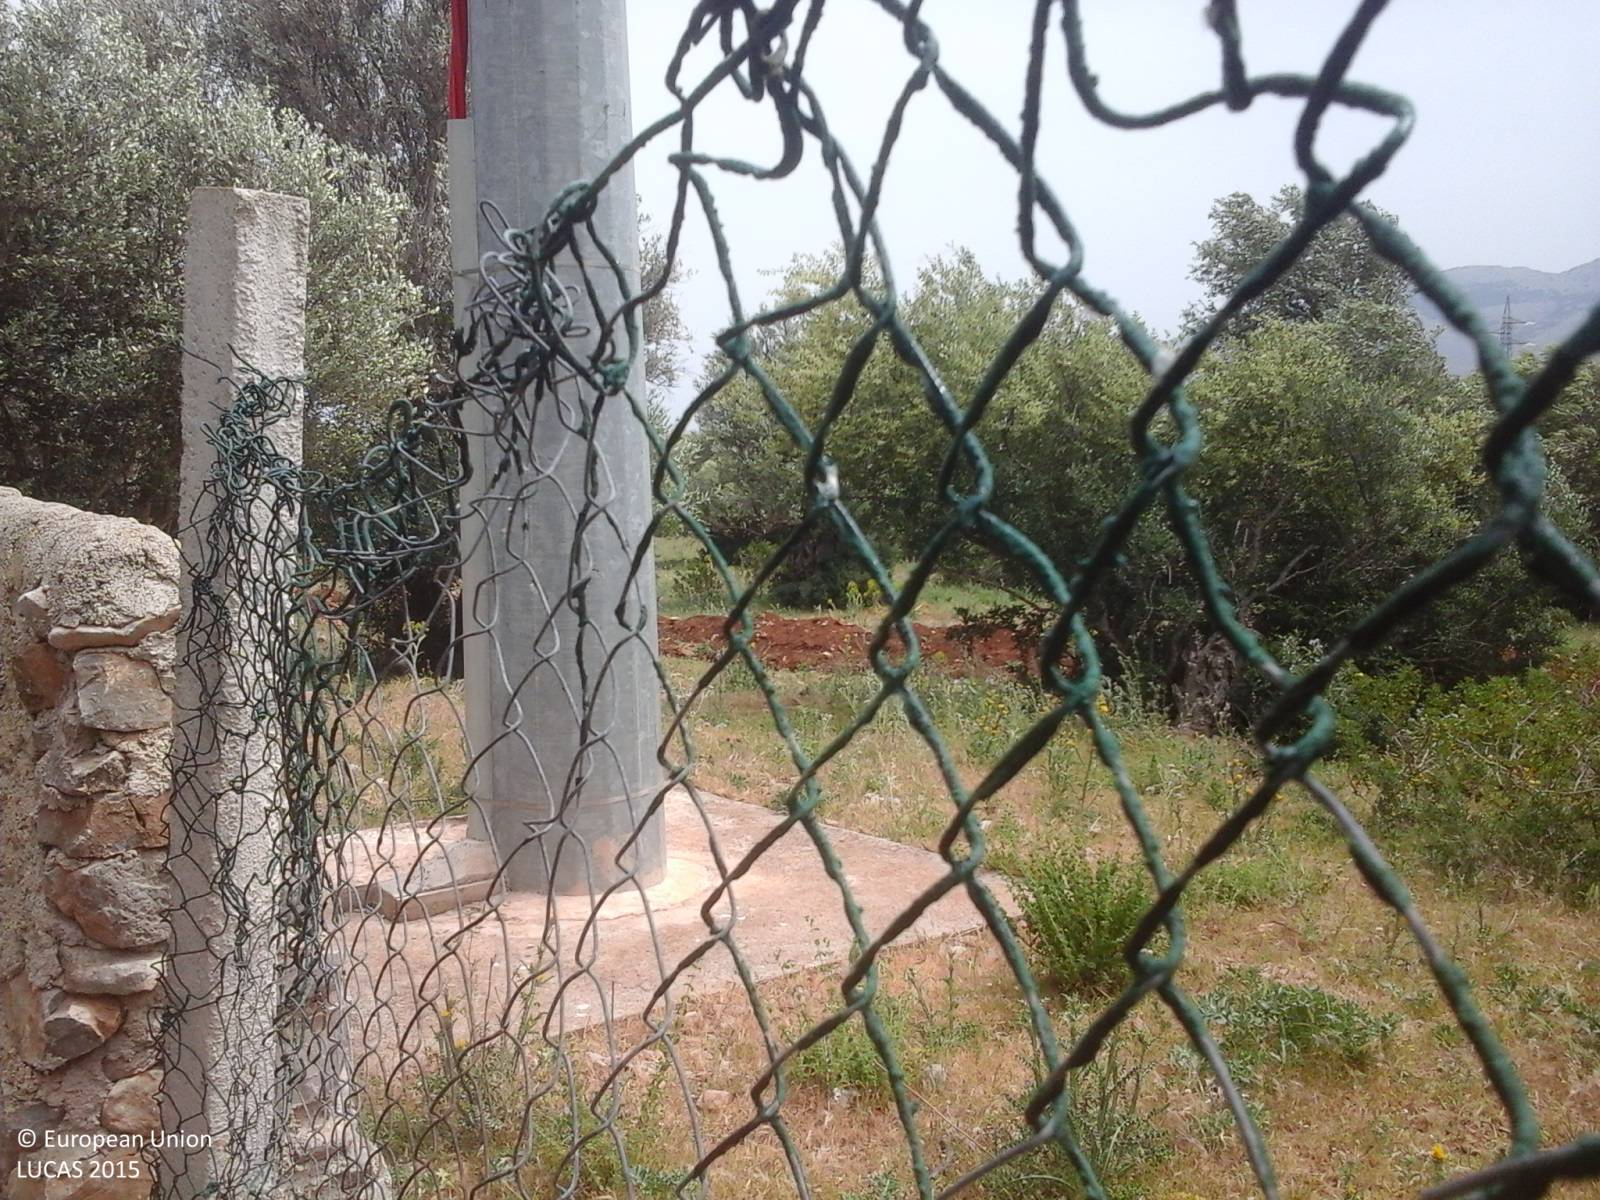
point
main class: Cropland
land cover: Olive groves
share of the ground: 25 - 50 %
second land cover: Spontaneously vegetated surfaces
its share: > 75 %
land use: Agriculture (excluding fallow land and kitchen gardens)
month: May
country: IT
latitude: 38.1490
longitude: 13.1616
